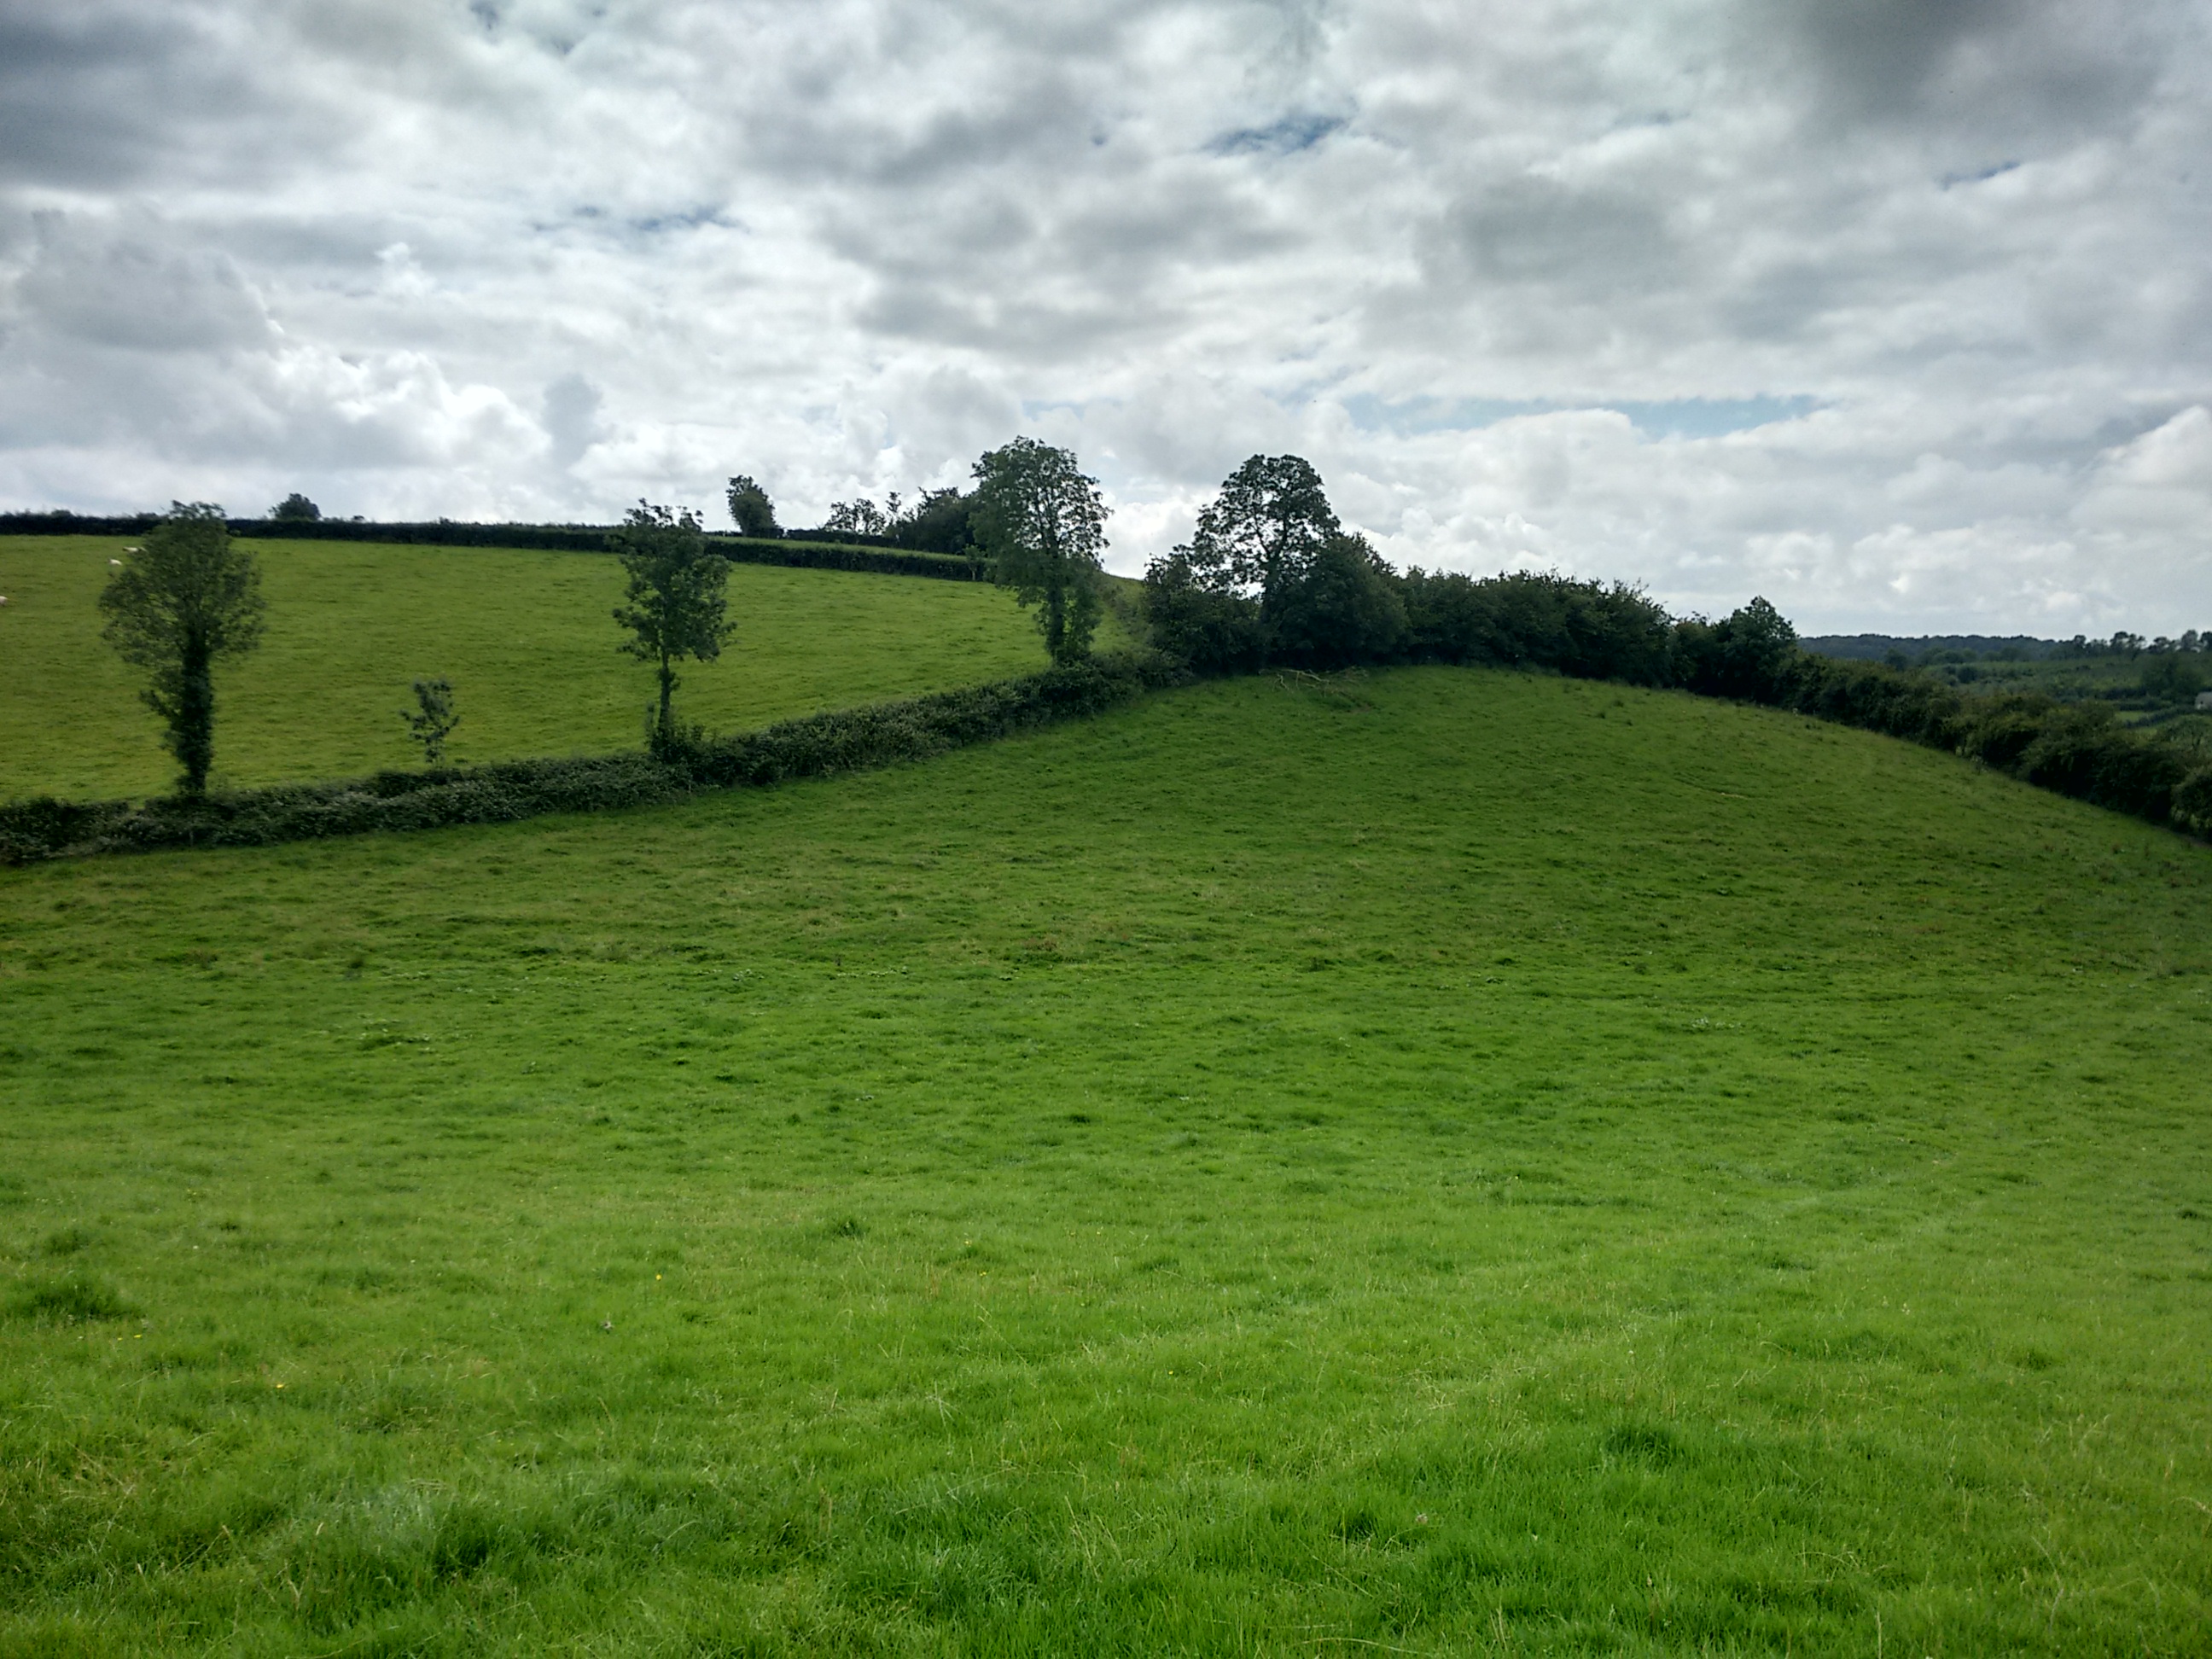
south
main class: Grassland
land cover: Grassland without tree/shrub cover
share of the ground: > 75 %
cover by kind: herbaceous plants 100 %
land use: Agriculture (excluding fallow land and kitchen gardens)
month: August
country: GB
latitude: 54.3769
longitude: -6.8704
